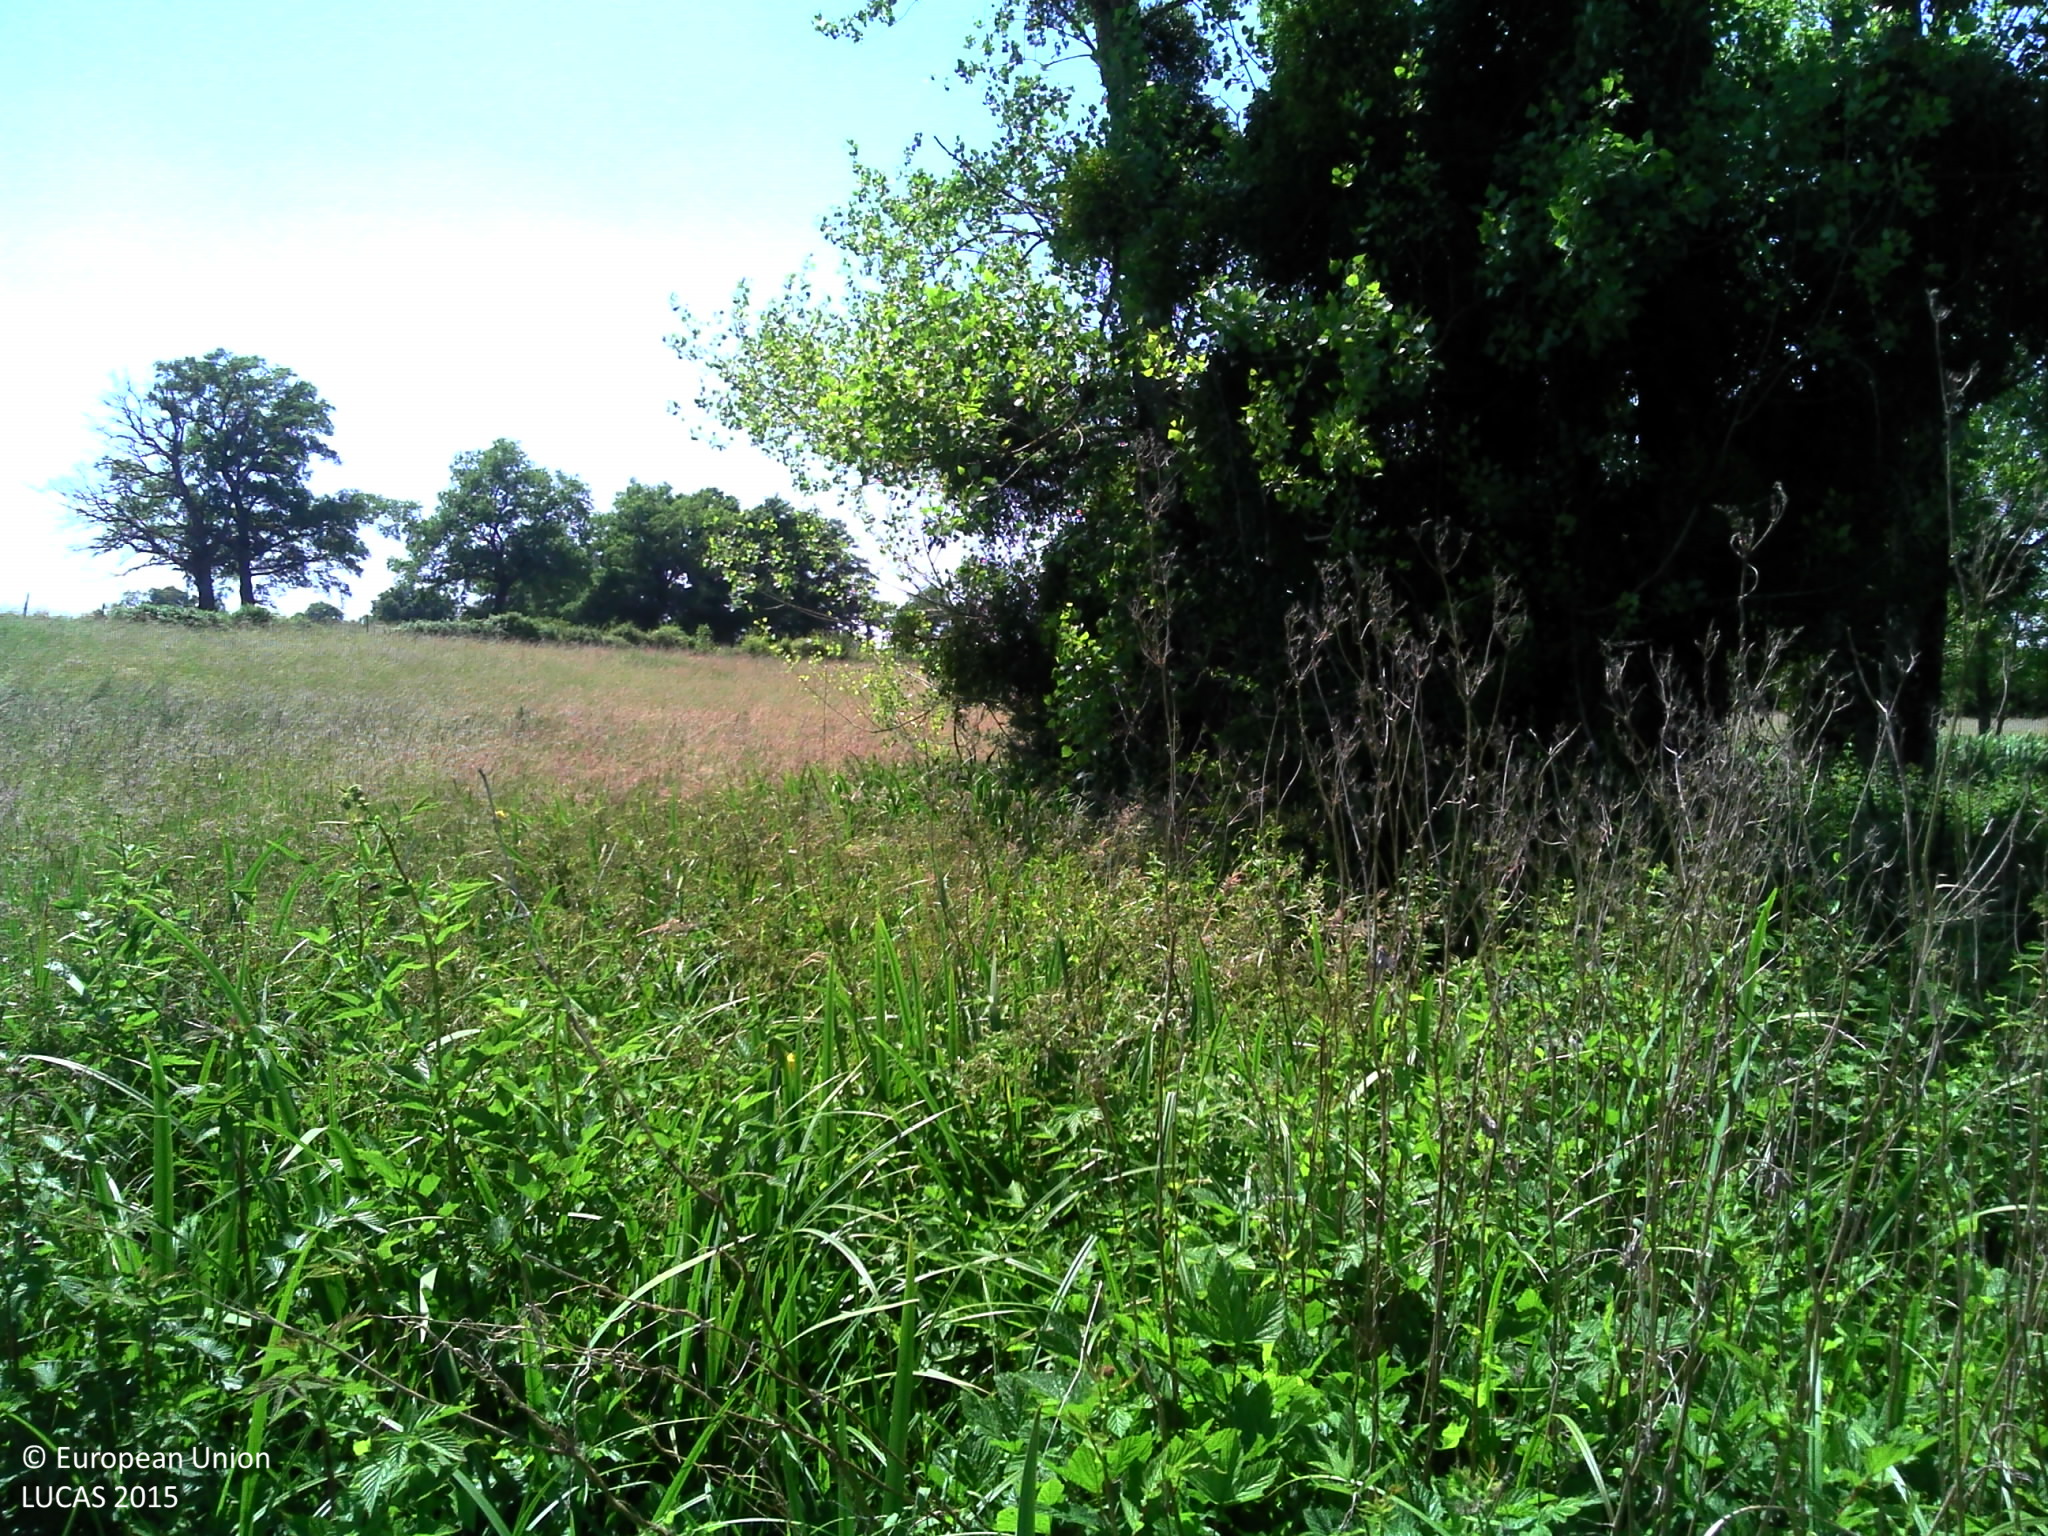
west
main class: Grassland
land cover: Spontaneously vegetated surfaces
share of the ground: > 75 %
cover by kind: herbaceous plants 95 %, shrubs 5 %
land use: Agriculture (excluding fallow land and kitchen gardens)
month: June
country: FR
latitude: 46.0577
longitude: 0.5359
